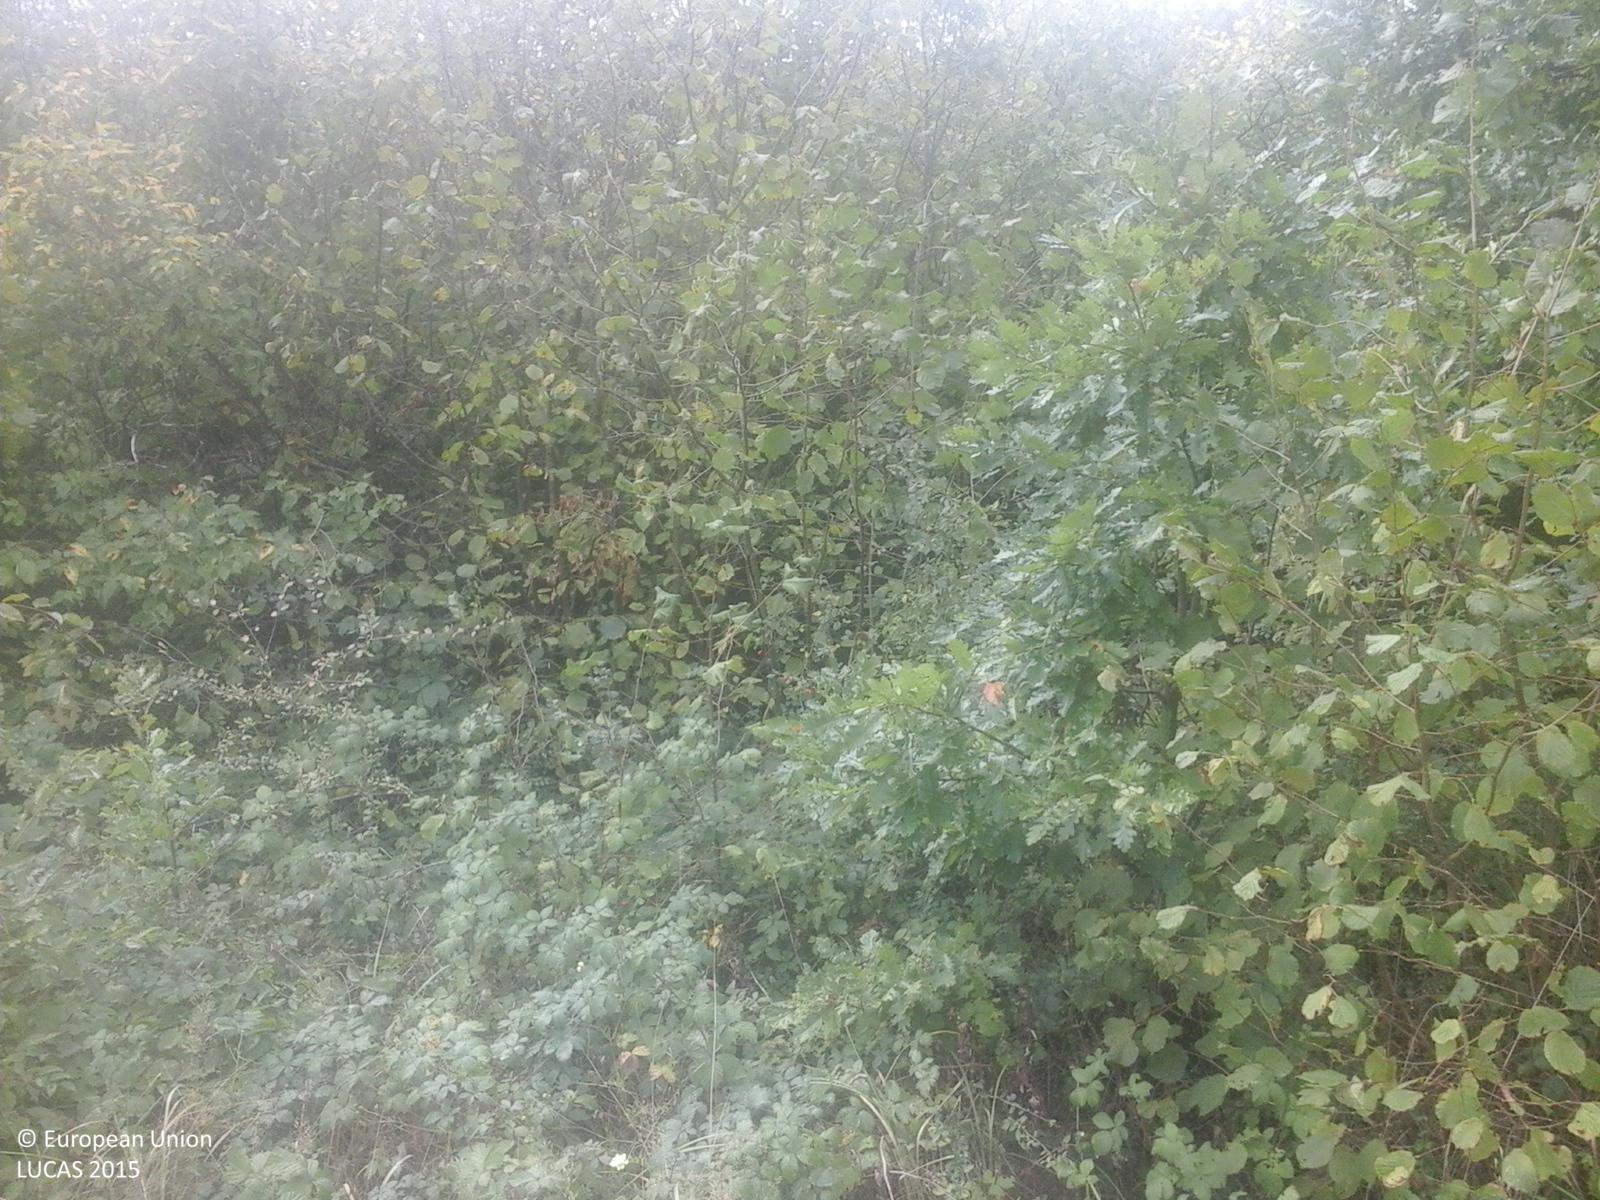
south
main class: Grassland
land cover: Grassland without tree/shrub cover
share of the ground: > 75 %
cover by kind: herbaceous plants 100 %
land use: Agriculture (excluding fallow land and kitchen gardens)
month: September
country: RO
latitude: 45.8663
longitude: 22.0599
